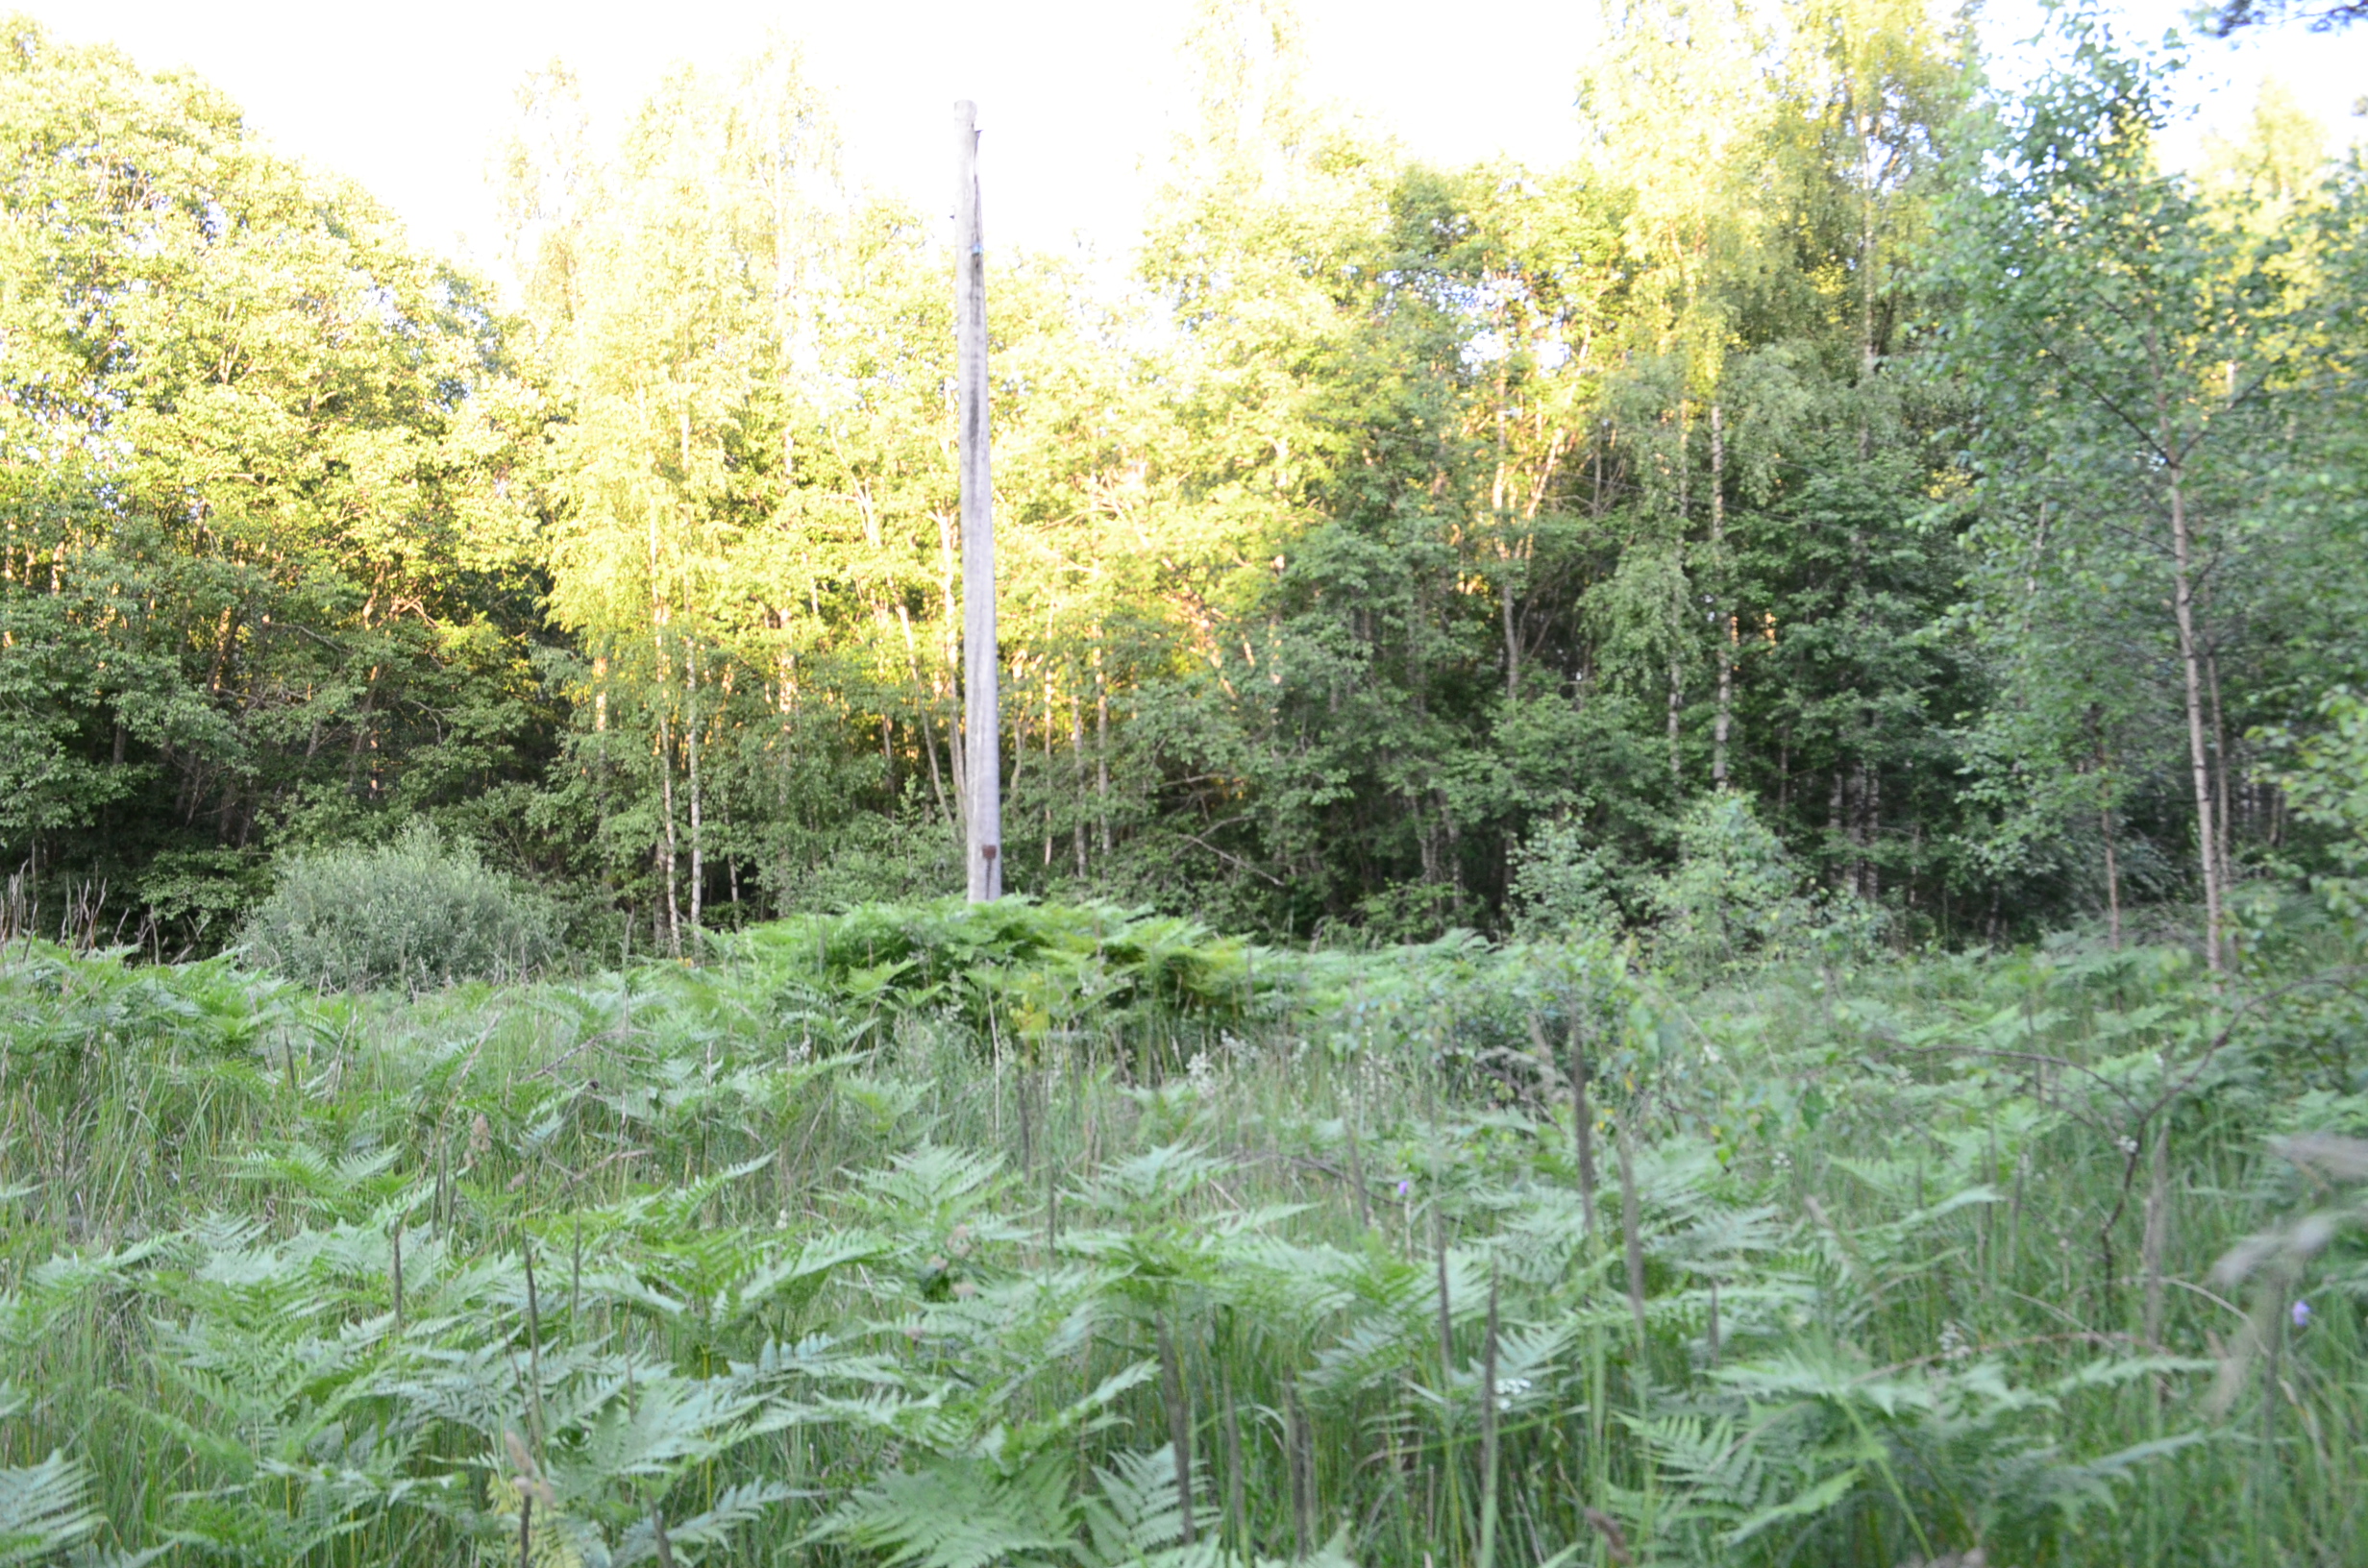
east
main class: Grassland
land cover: Grassland with sparse tree/shrub cover
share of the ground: > 75 %
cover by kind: herbaceous plants 95 %, broadleaved forest trees 5 %
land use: Semi-natural and natural areas not in use
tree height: < 5 m
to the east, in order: Grassland with sparse tree/shrub cover; Electric lines; Grassland with sparse tree/shrub cover; Broadleaved woodland; Ditches and canals; Broadleaved woodland; Other mixed woodland; Spontaneously vegetated surfaces
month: July
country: LV
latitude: 57.0973
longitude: 22.3826
